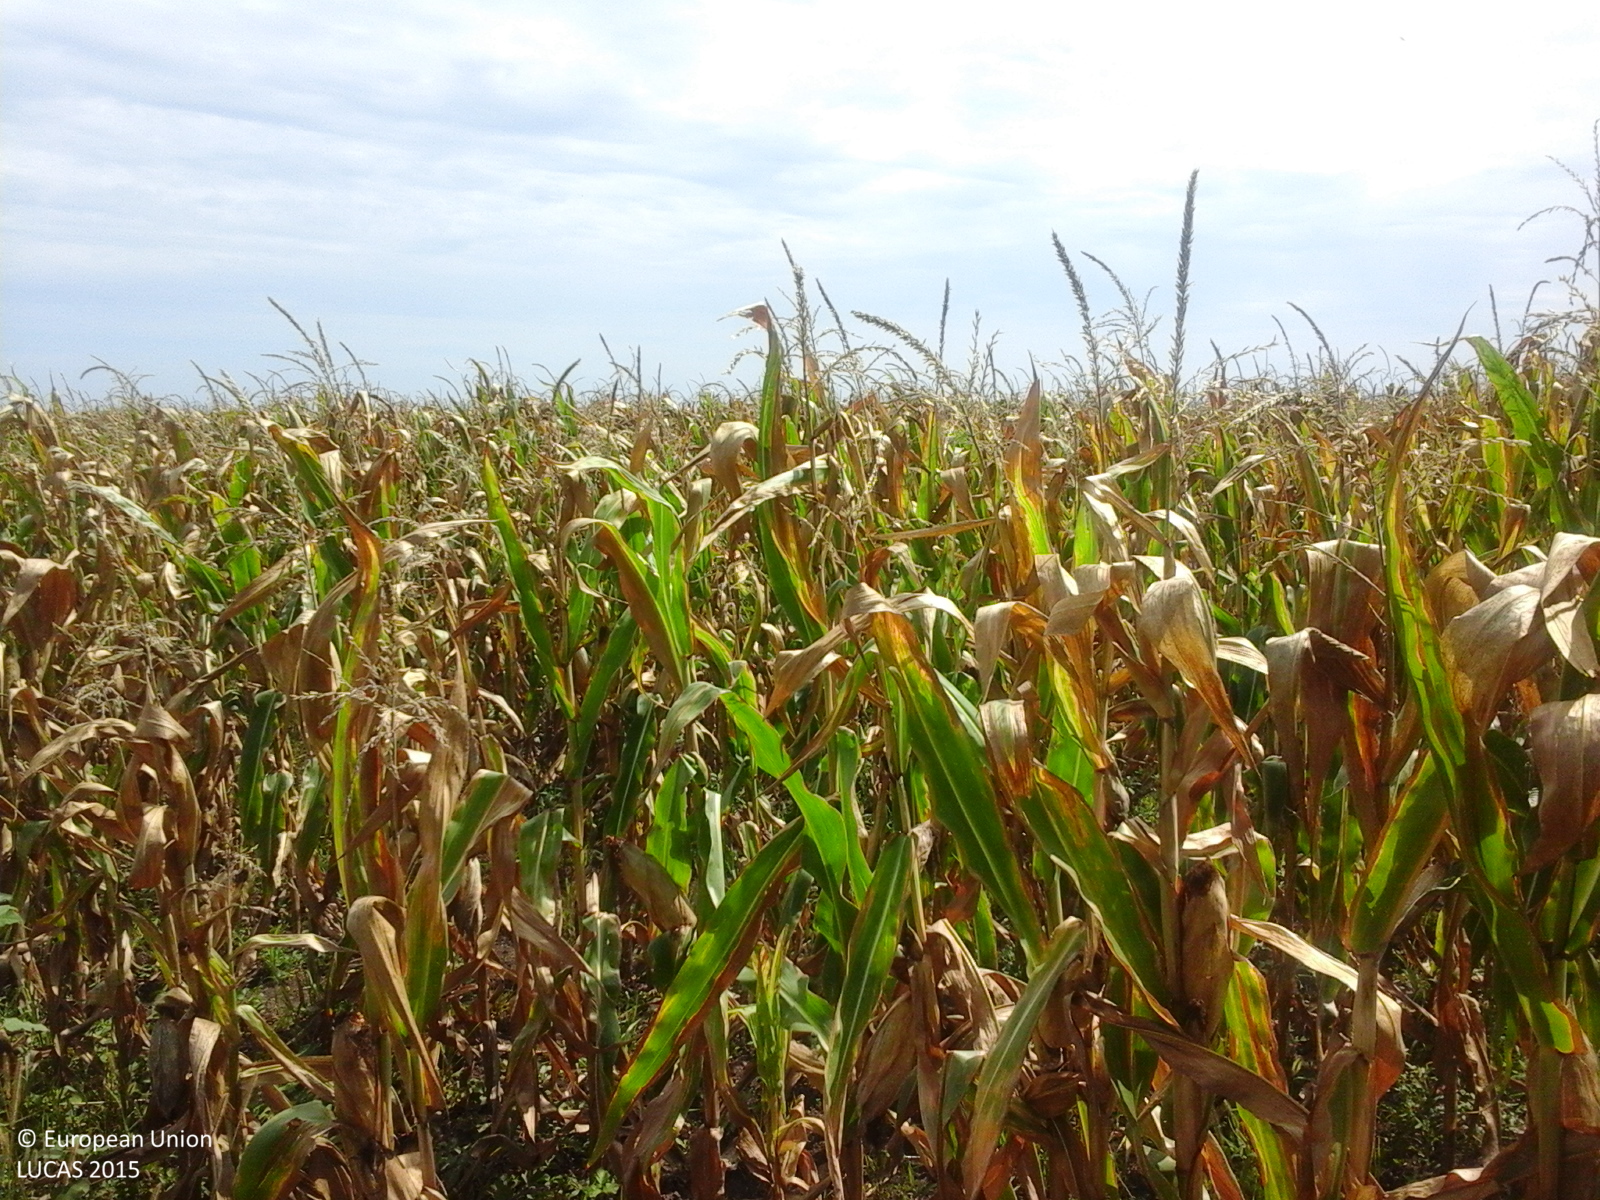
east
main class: Cropland
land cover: Maize
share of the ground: > 75 %
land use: Agriculture (excluding fallow land and kitchen gardens)
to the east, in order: Maize; Common wheat
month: August
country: RO
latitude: 46.3814
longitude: 21.5182
